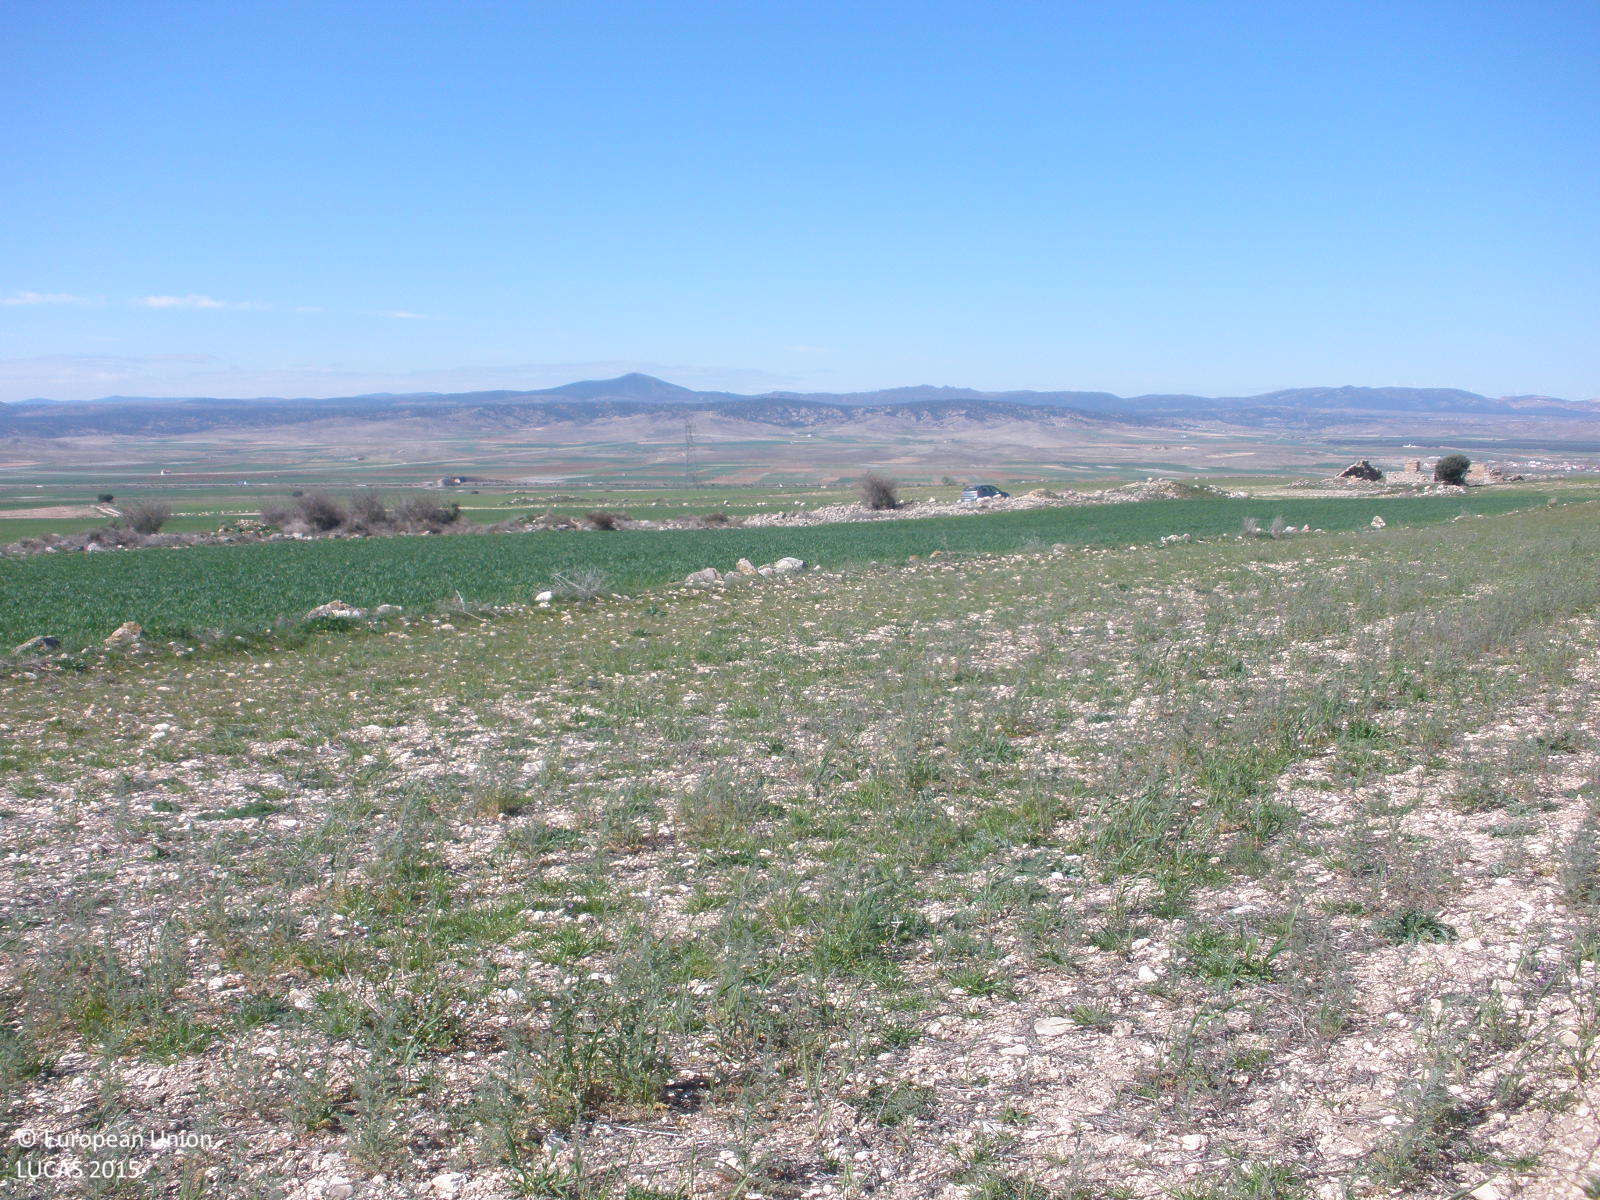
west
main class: Grassland
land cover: Spontaneously vegetated surfaces
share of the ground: 50 - 75 %
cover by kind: herbaceous plants 75 %, unconsolidated bare surface 25 %
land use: Agriculture (excluding fallow land and kitchen gardens)
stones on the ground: 25 - 50 %
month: April
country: ES
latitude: 40.6897
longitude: -1.2926
